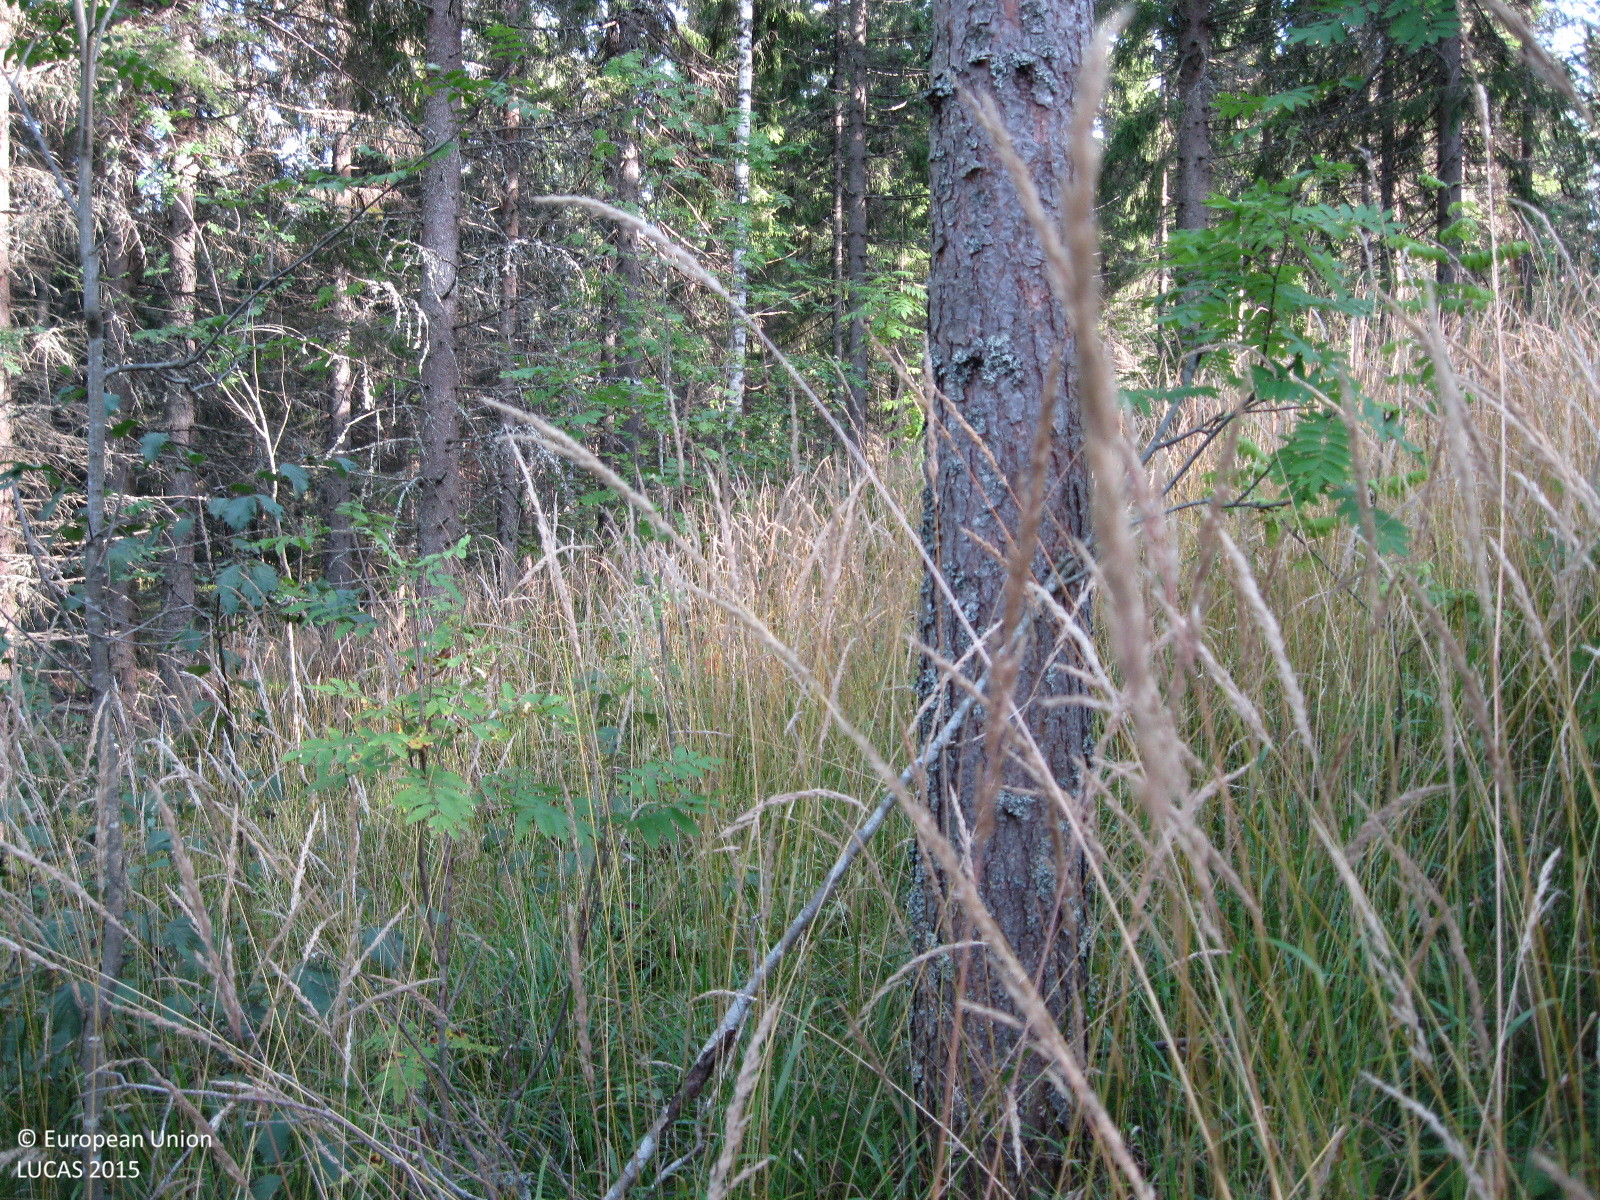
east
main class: Woodland
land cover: Pine dominated coniferous woodland
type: boreal forest
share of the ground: > 75 %
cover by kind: coniferous forest trees 70 %, herbaceous plants 25 %, broadleaved forest trees 5 %
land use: Forestry
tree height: > 5 m
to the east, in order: Pine dominated coniferous woodland; Spruce dominated mixed woodland; Ditches and canals; Pine dominated mixed woodland; Spruce dominated coniferous woodland; Ditches and canals; Pine dominated mixed woodland
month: September
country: FI
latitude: 60.5352
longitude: 24.5973
